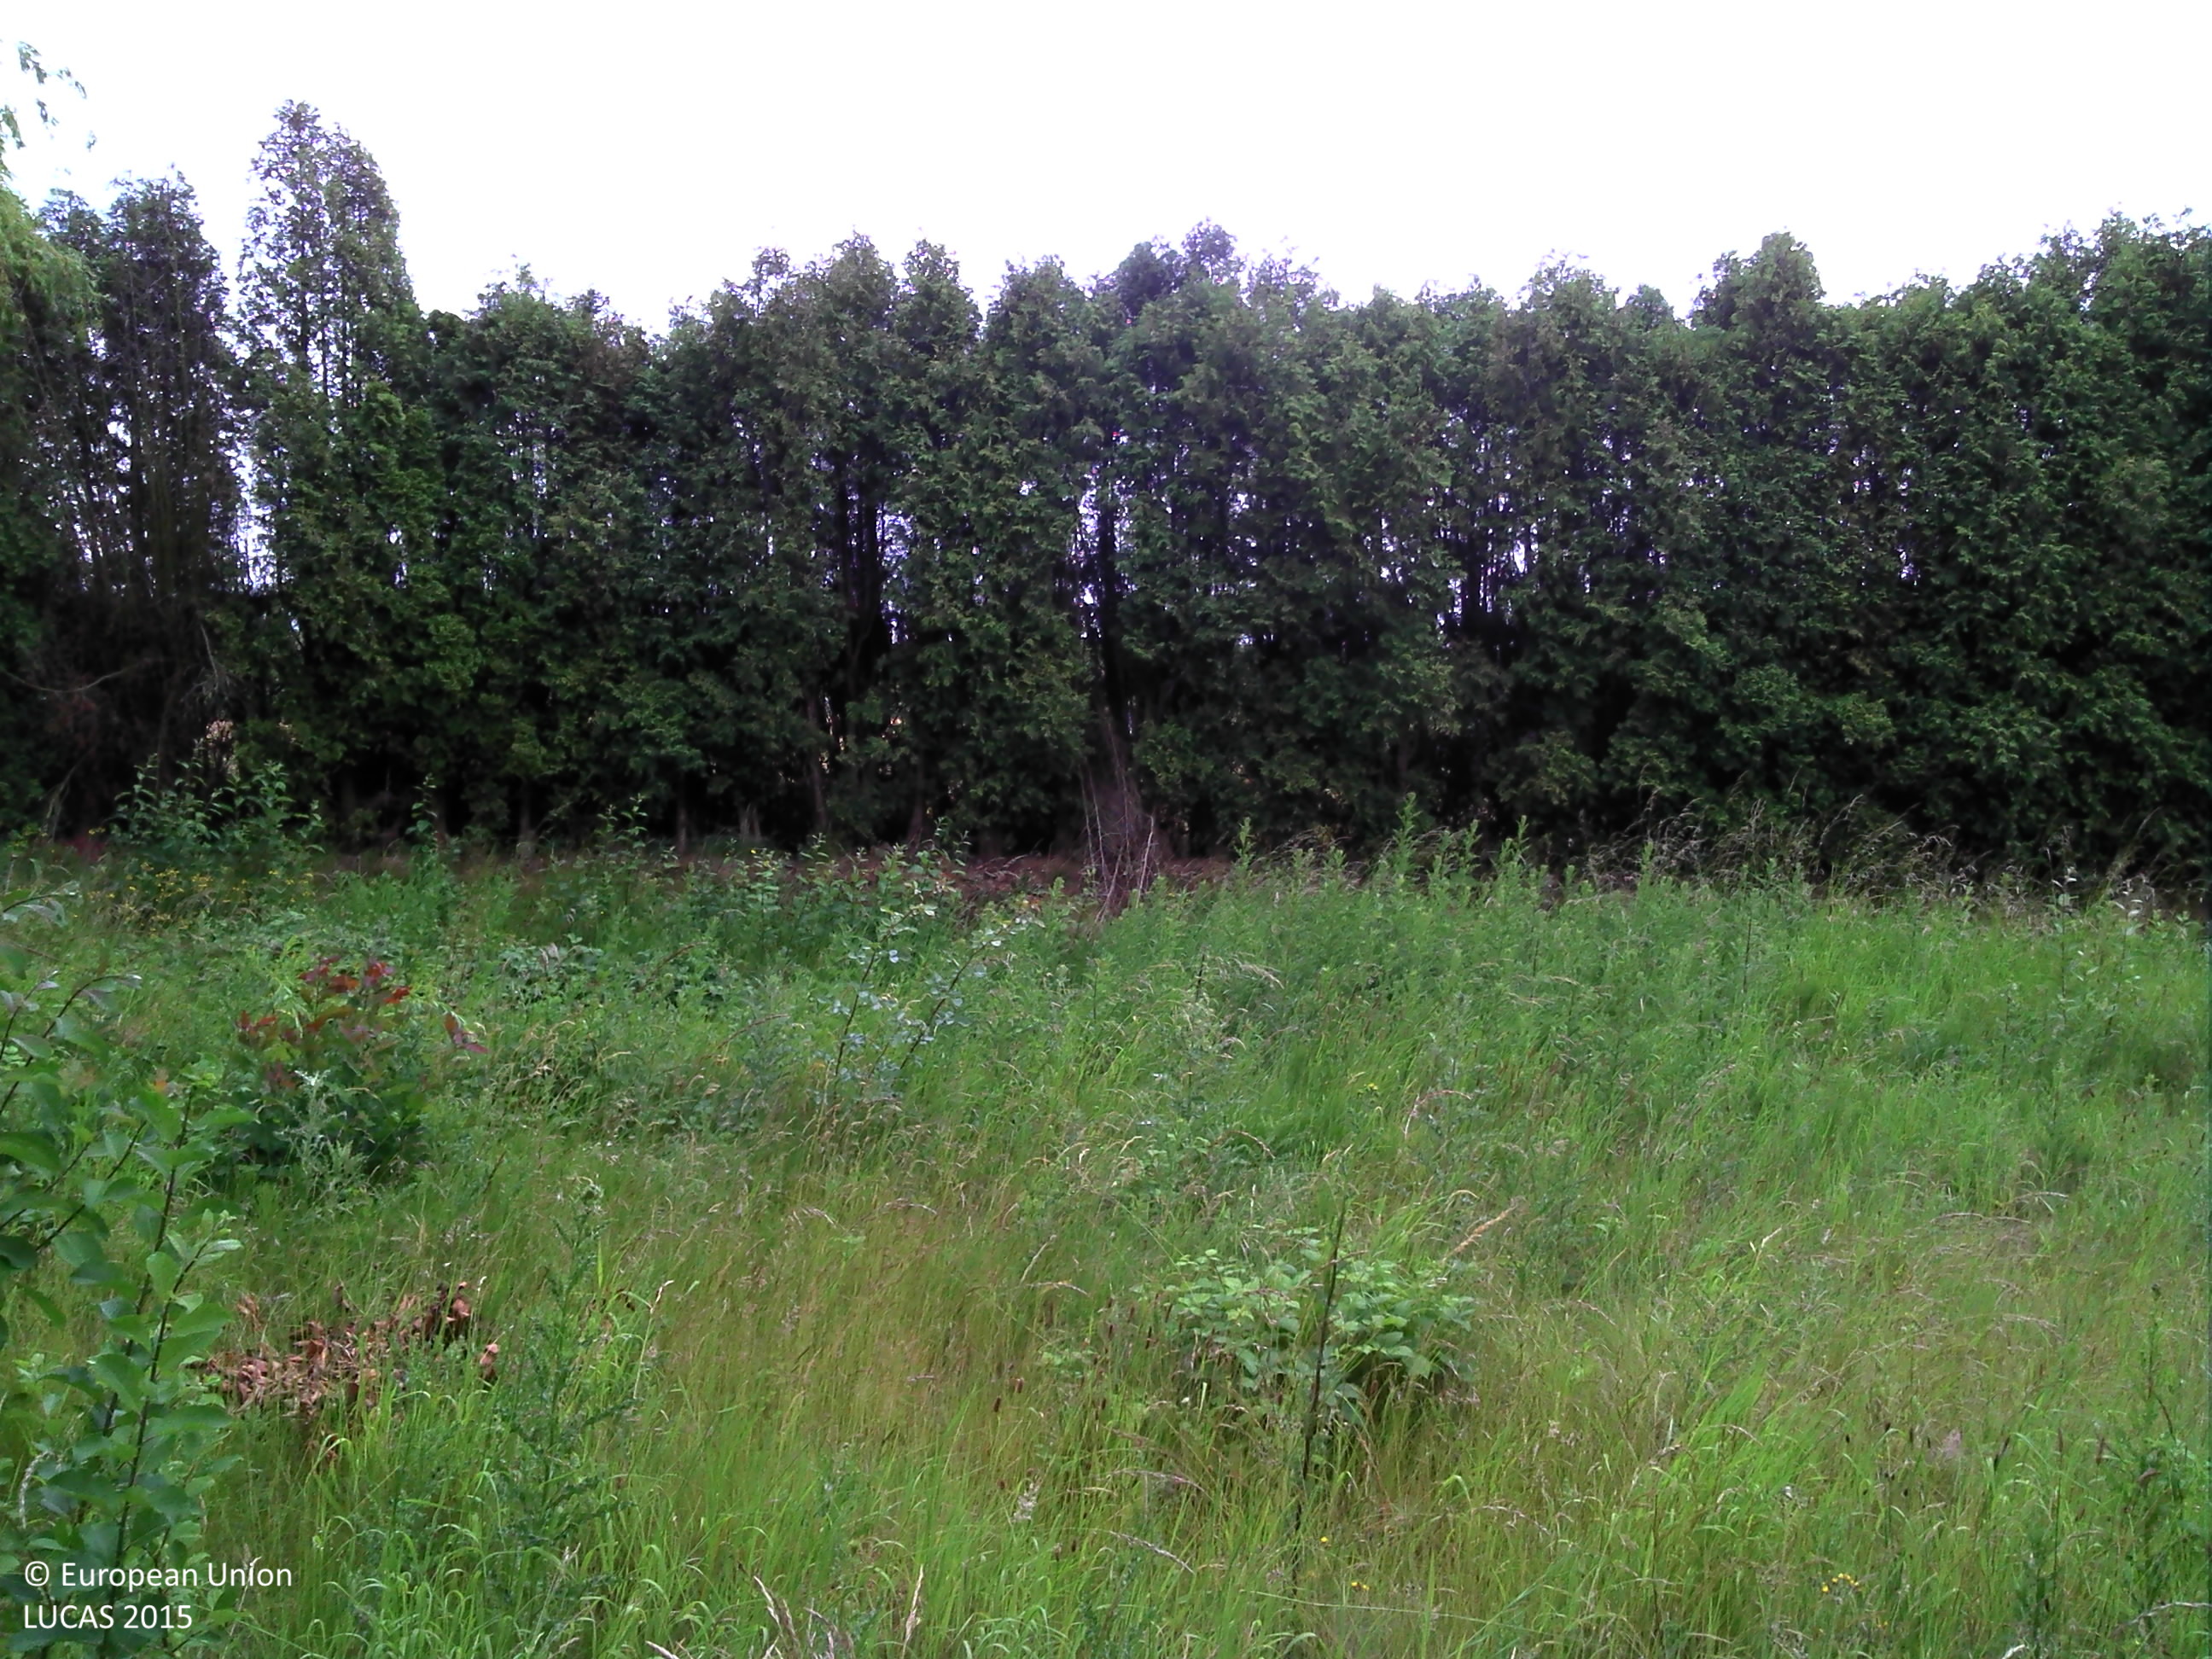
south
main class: Grassland
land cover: Grassland without tree/shrub cover
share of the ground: > 75 %
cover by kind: herbaceous plants 100 %
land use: Abandoned areas
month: June
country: BE
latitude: 50.6521
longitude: 5.4579
